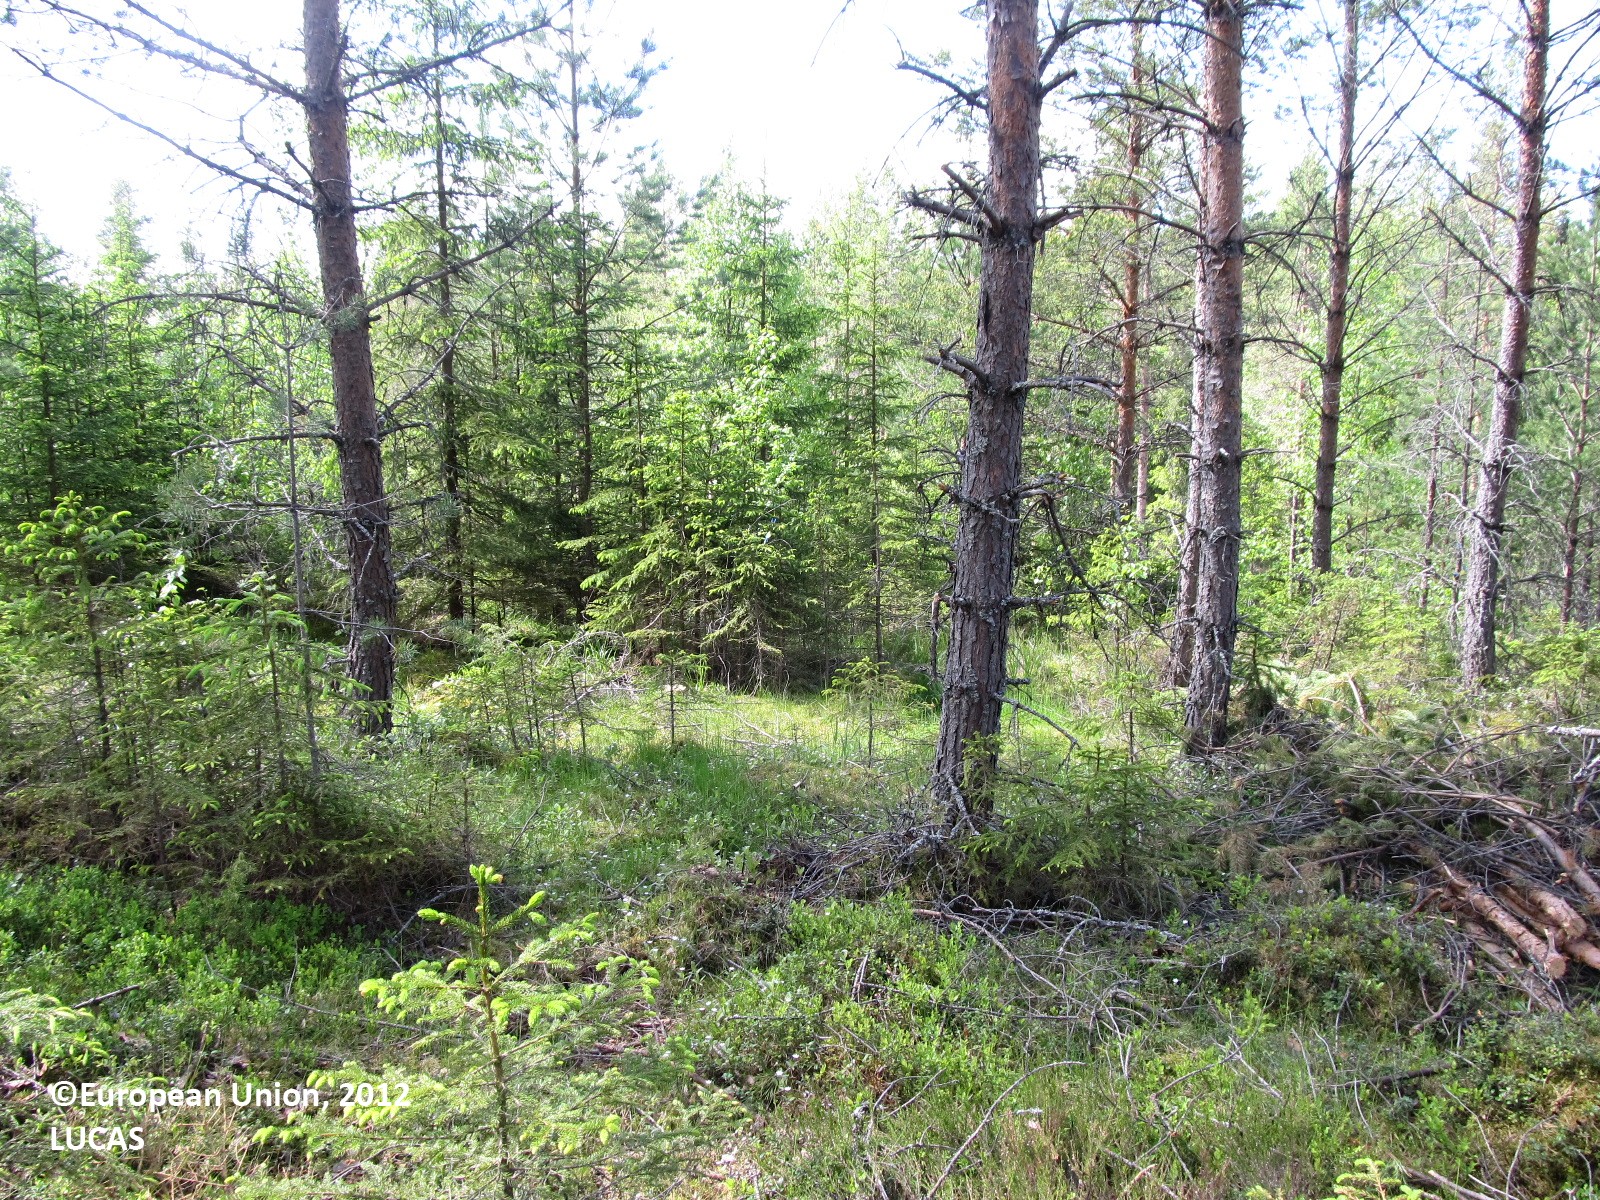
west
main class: Woodland
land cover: Pine dominated coniferous woodland
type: boreal forest
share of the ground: 25 - 50 %
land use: Forestry
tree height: > 5 m
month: June
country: FI
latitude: 62.7193
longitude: 27.5520
